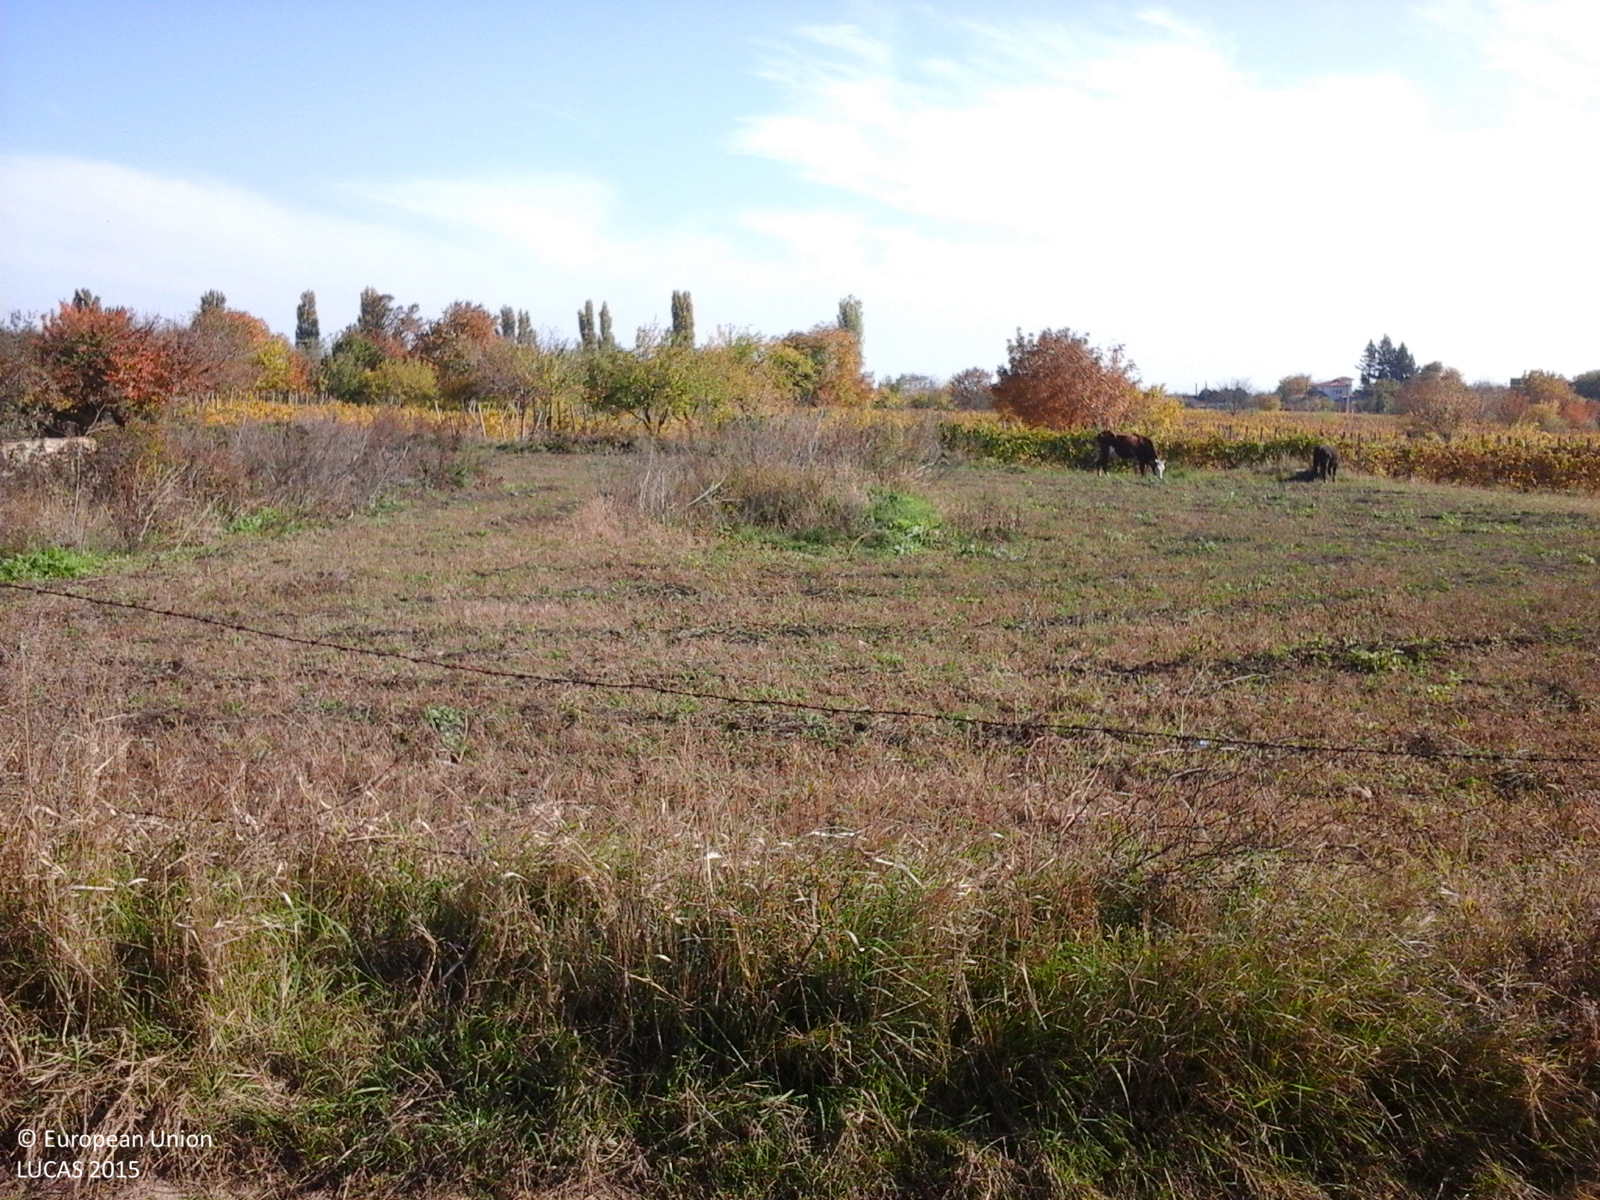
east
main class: Cropland
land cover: Vineyards
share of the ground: 50 - 75 %
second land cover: Other bare soil
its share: > 75 %
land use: Agriculture (excluding fallow land and kitchen gardens)
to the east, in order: Vineyards; Other bare soil; Tracks; Grass margins; Fences; Grassland without tree/shrub cover; Vineyards; Other fruit trees and berries; Tracks; Vineyards; Grassland without tree/shrub cover; Fences; Other fruit trees and berries; Fences; Artificial constructions in urban areas; Other fruit trees and berries
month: October
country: RO
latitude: 45.6296
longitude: 27.0610
